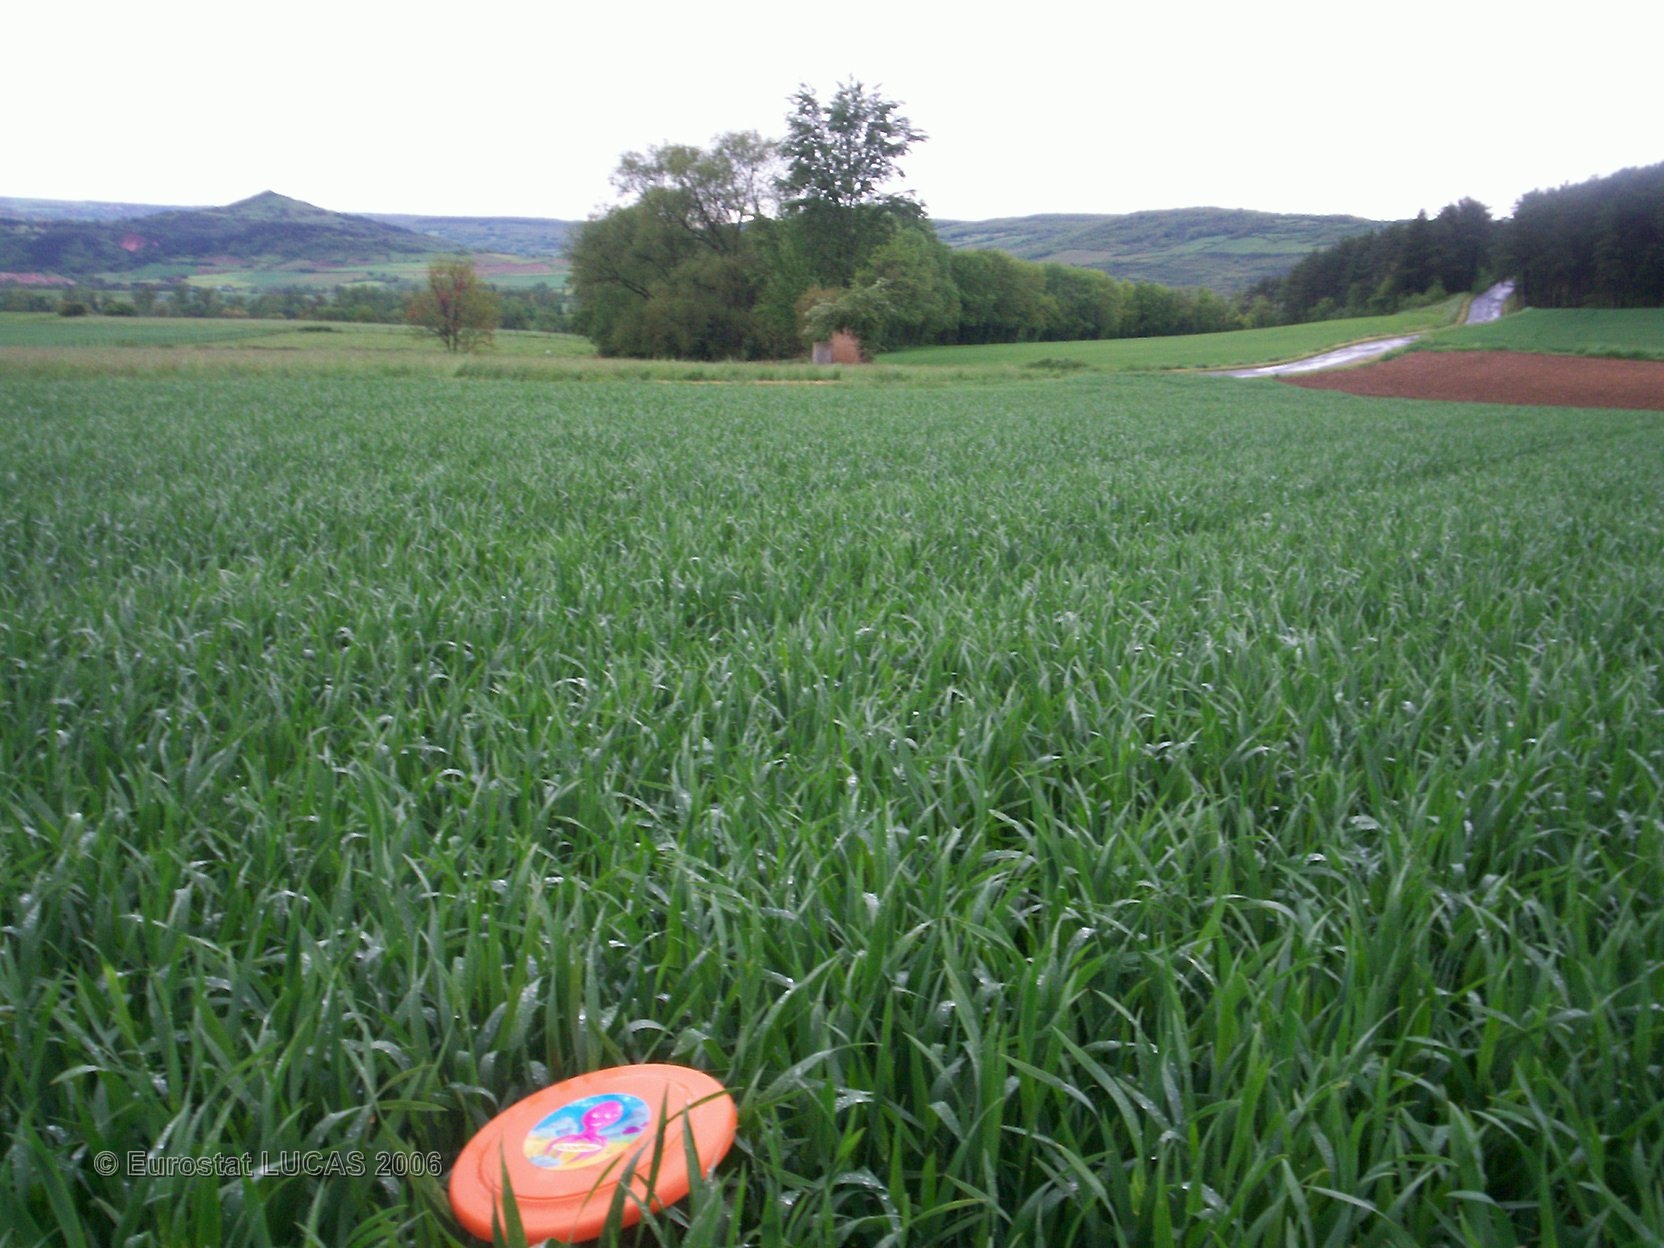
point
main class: Cropland
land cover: Common wheat
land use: Agriculture (excluding fallow land and kitchen gardens)
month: May
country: FR
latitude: 45.4306
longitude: 3.2140
